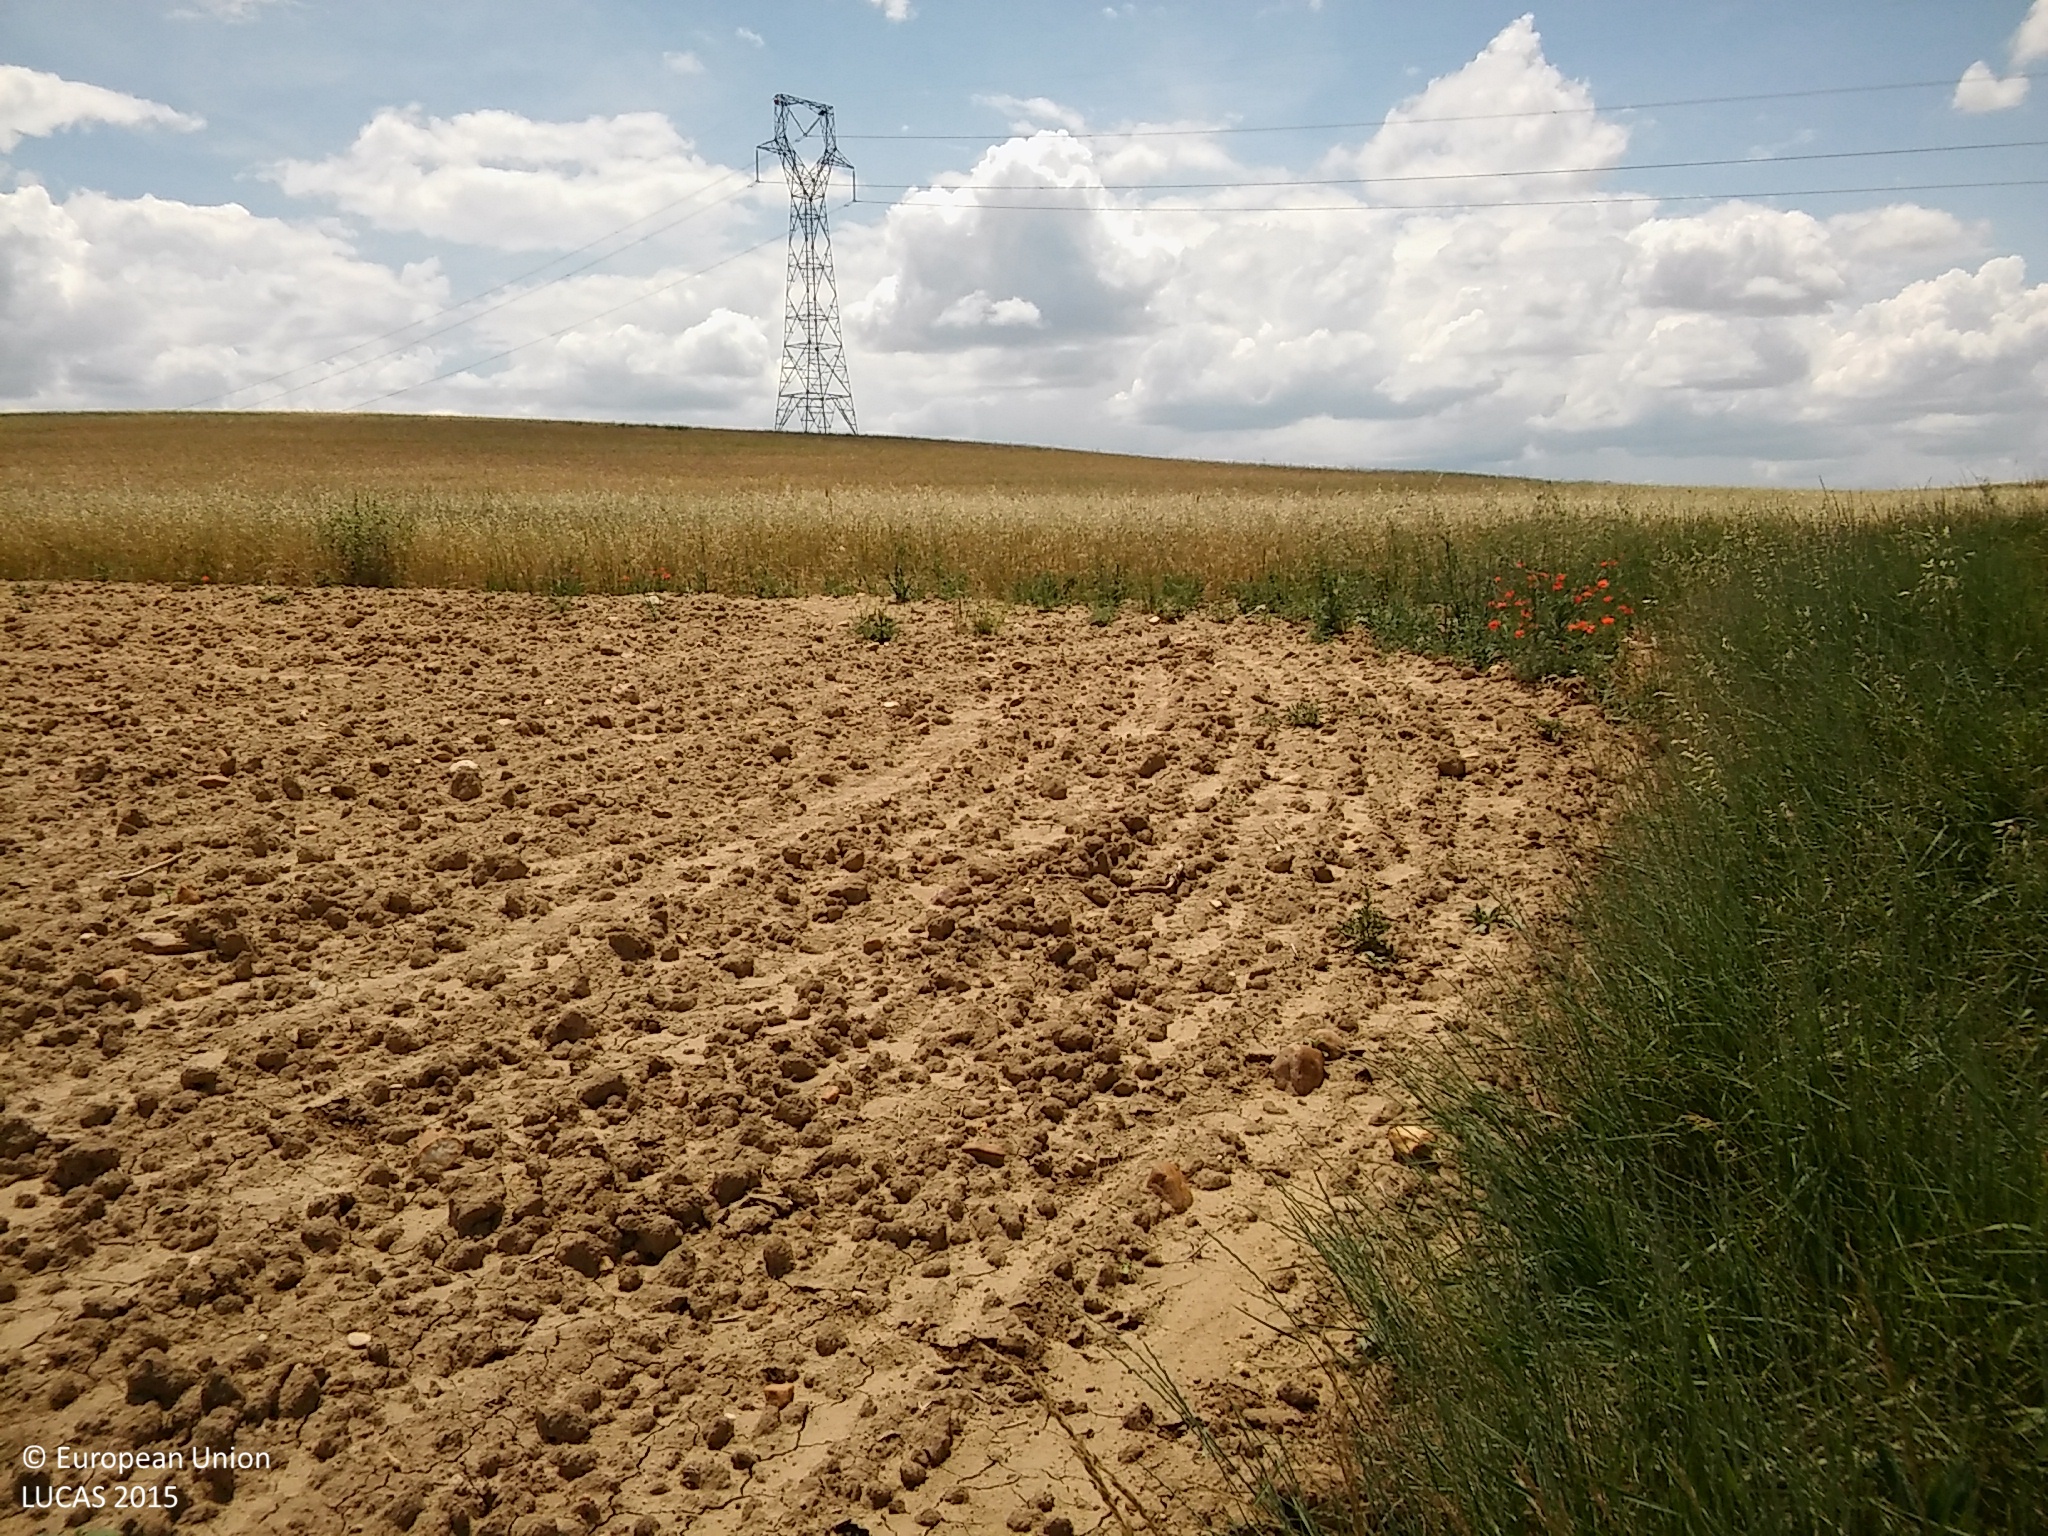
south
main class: Grassland
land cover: Grassland without tree/shrub cover
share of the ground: > 75 %
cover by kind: herbaceous plants 100 %
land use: Semi-natural and natural areas not in use
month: June
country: ES
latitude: 41.2798
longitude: -3.6946
